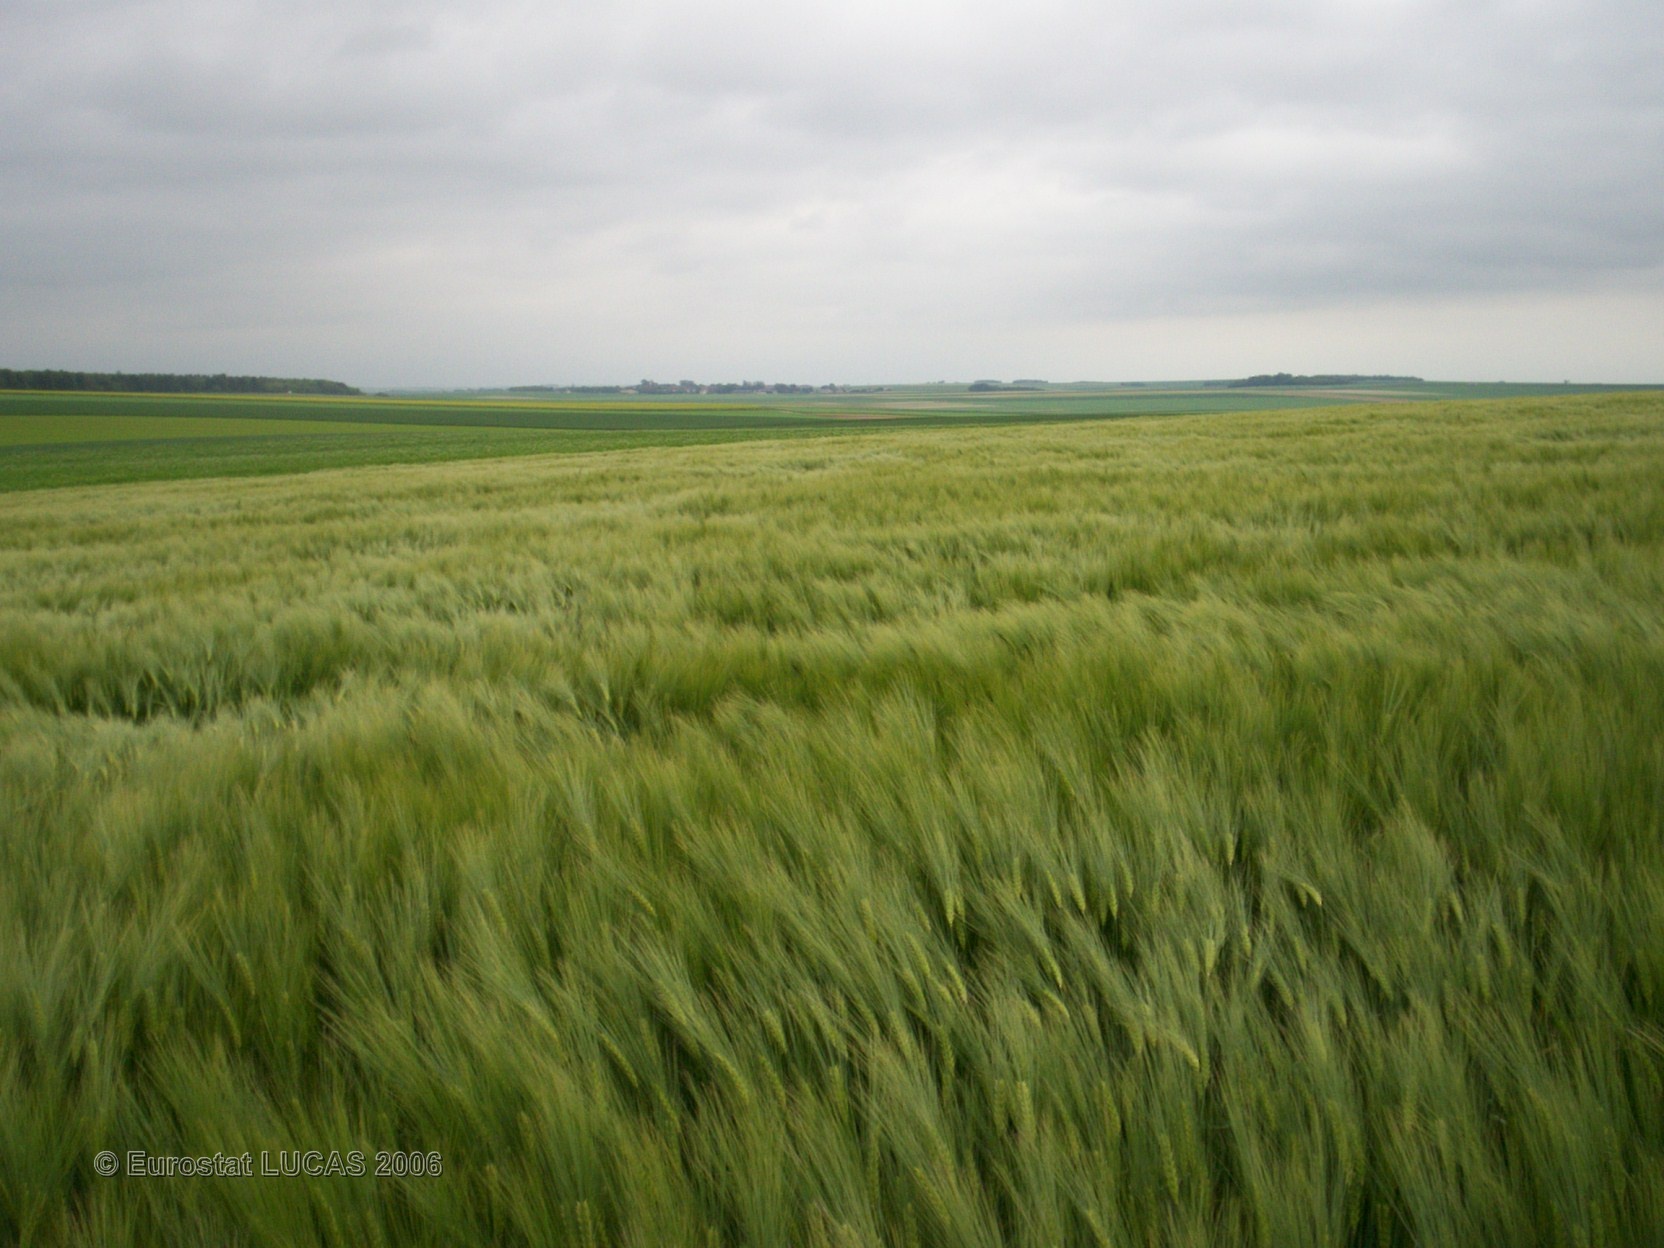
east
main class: Cropland
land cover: Barley
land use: Agriculture (excluding fallow land and kitchen gardens)
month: May
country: FR
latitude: 49.3447
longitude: 4.4216
